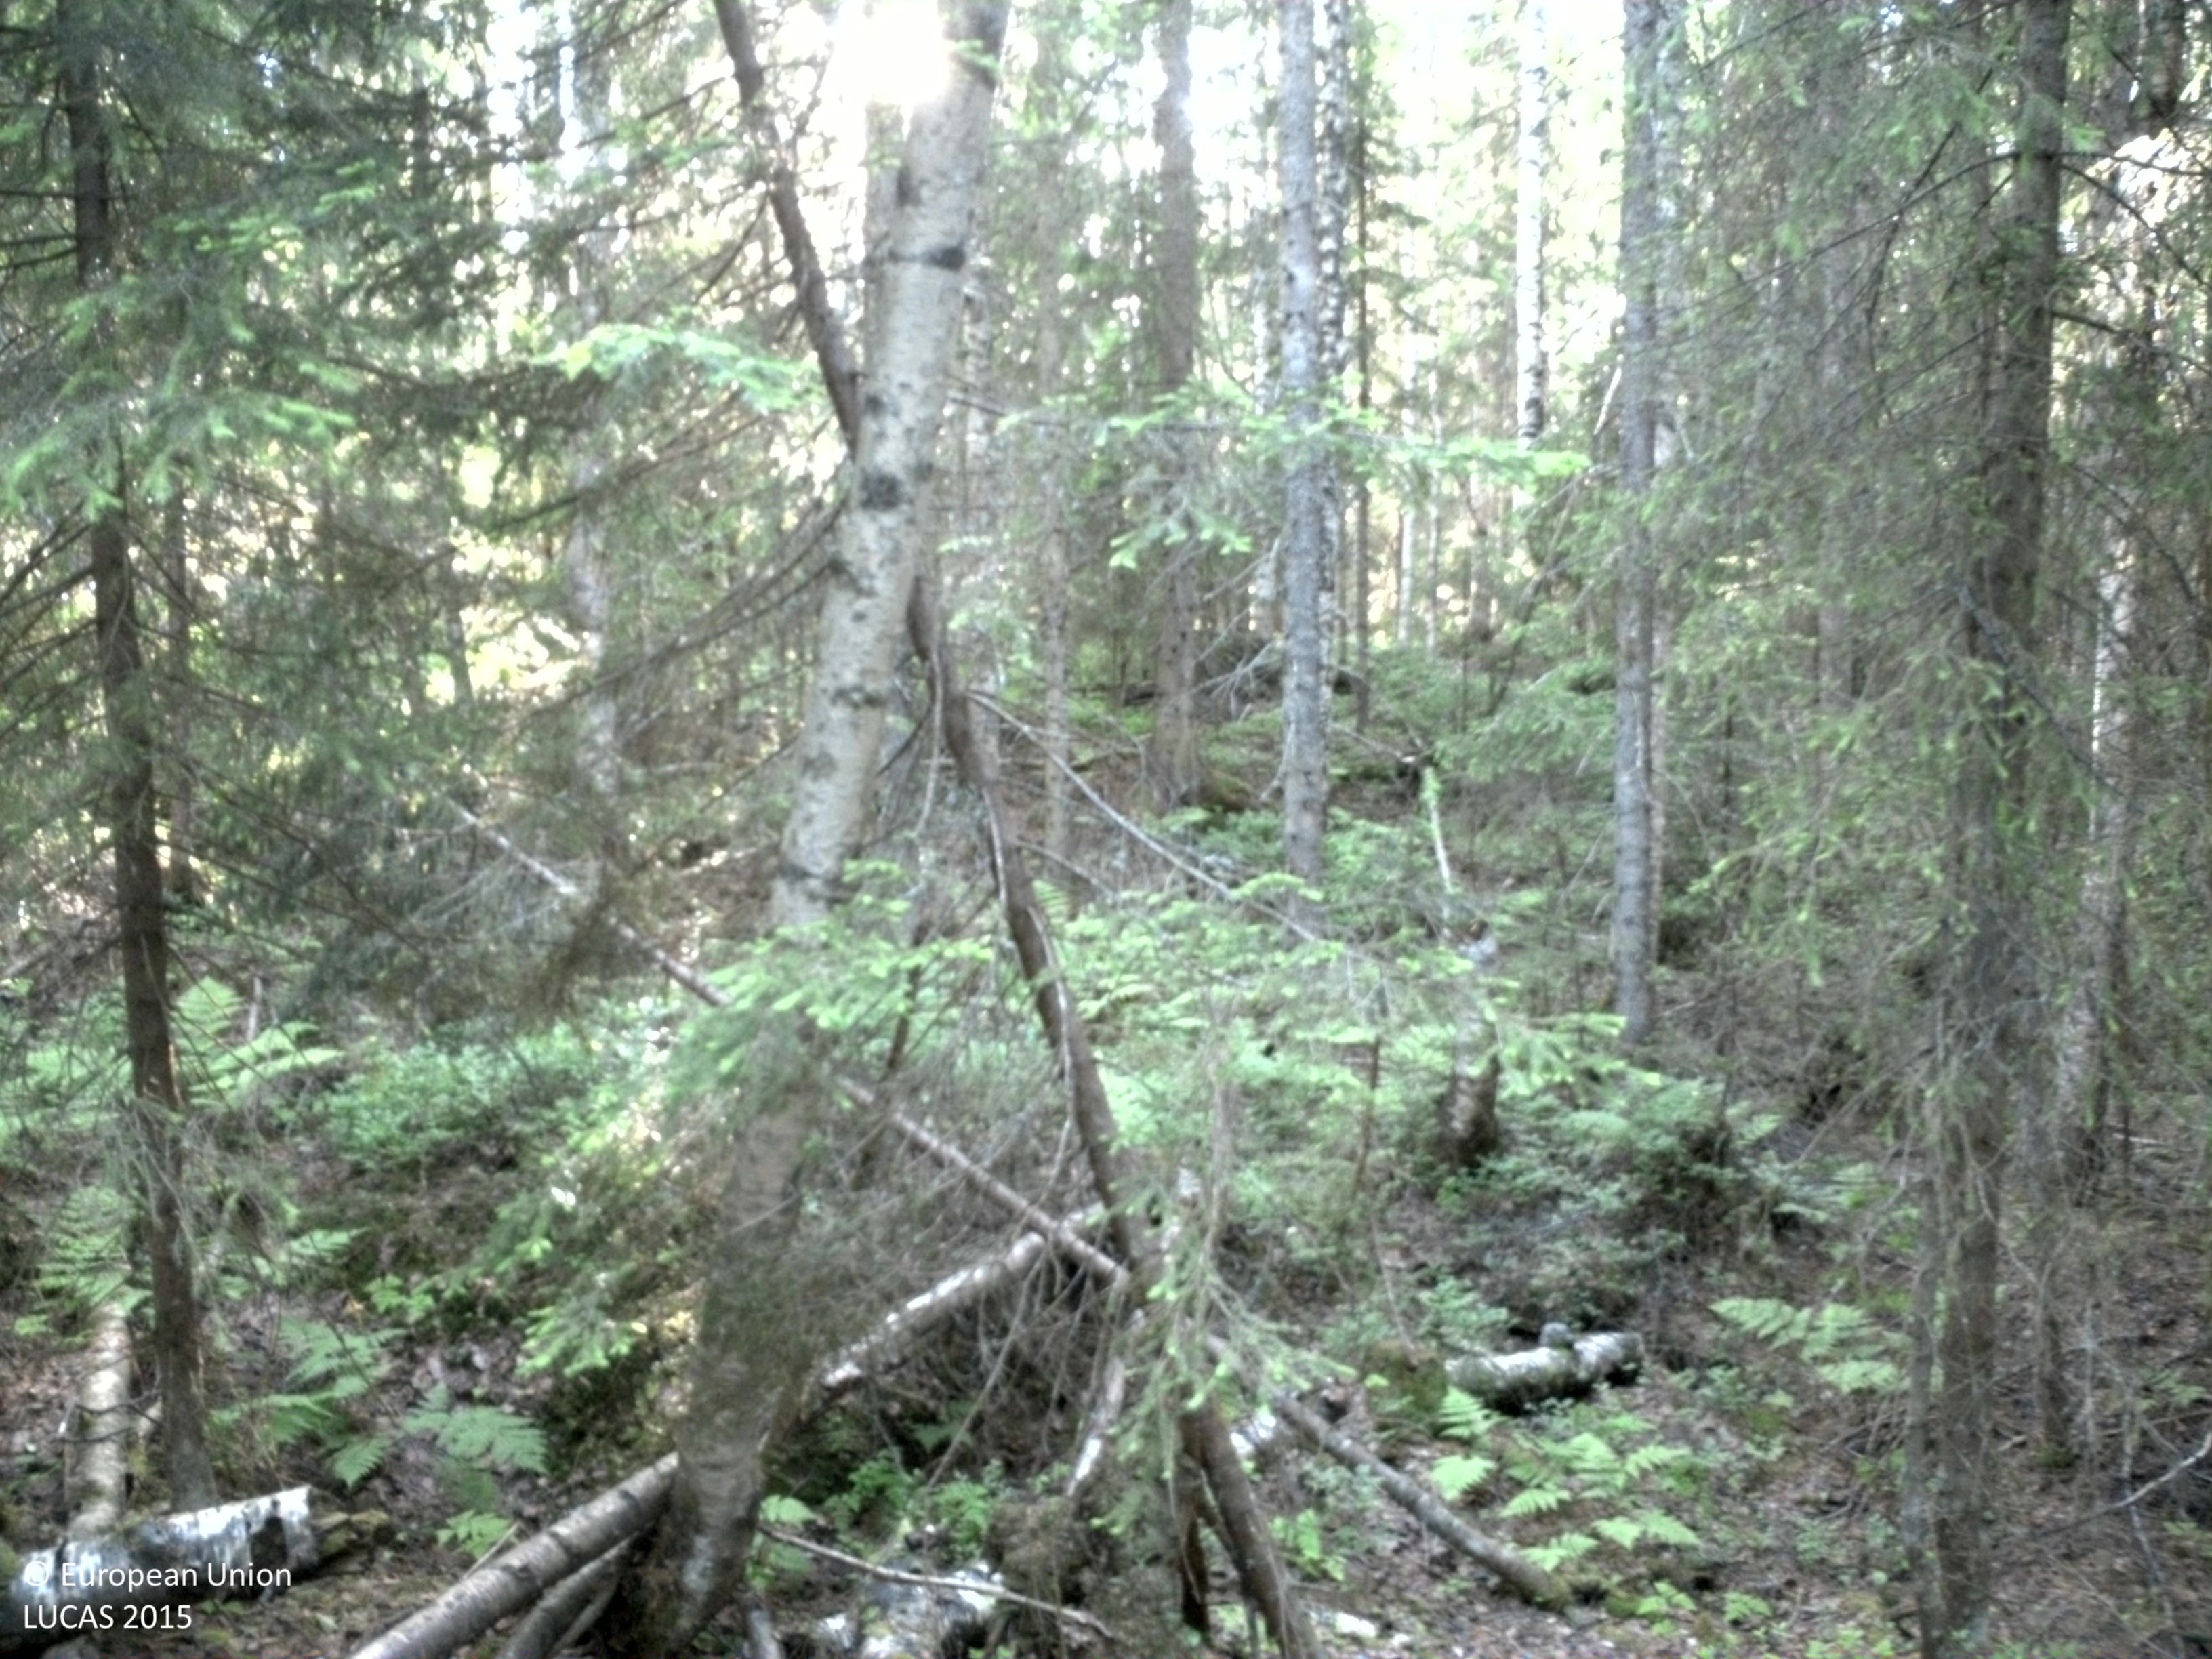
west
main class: Woodland
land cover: Spruce dominated mixed woodland
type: boreal forest
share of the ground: 50 - 75 %
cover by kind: coniferous forest trees 50 %, broadleaved forest trees 25 %, shrubs 25 %
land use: Forestry
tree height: > 5 m
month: July
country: SE
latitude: 64.3060
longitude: 20.7510
